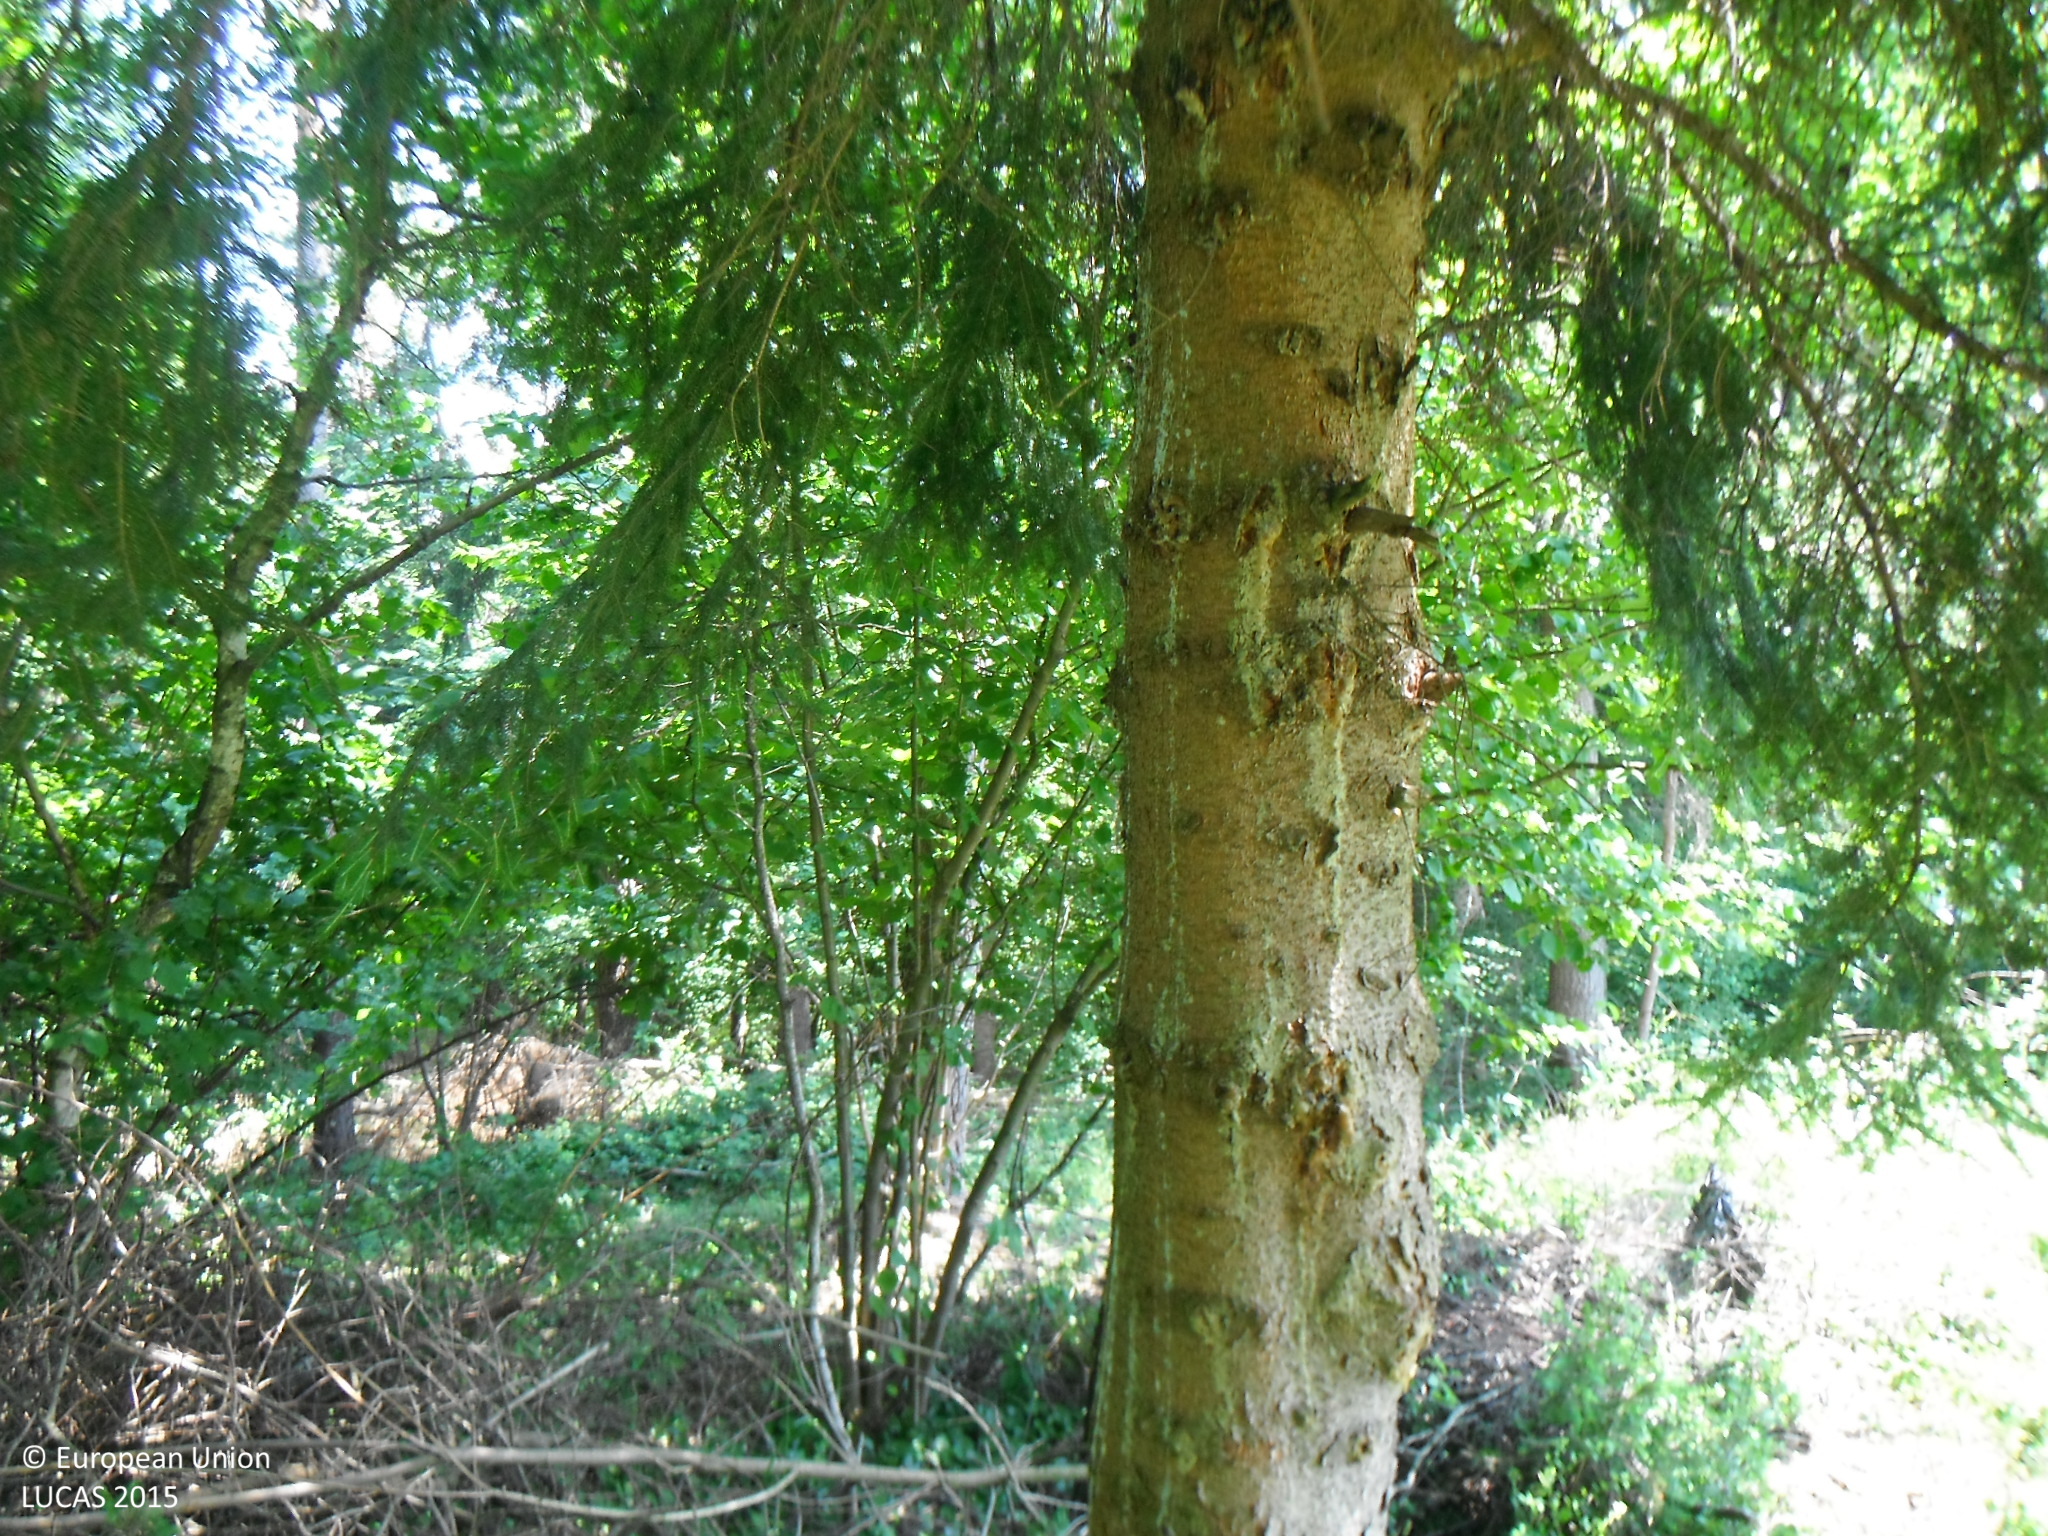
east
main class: Woodland
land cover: Spruce dominated mixed woodland
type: hemiboreal forest and nemoral coniferous forest and mixed broadleaved-coniferous forest
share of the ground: > 75 %
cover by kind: coniferous forest trees 50 %, broadleaved forest trees 25 %, herbaceous plants 15 %, shrubs 10 %
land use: Forestry
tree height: > 5 m
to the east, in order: Spruce dominated mixed woodland; Pine dominated mixed woodland; Tracks; Spruce dominated coniferous woodland; Pine dominated coniferous woodland; Spruce dominated coniferous woodland
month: July
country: SK
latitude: 49.2698
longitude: 18.4978
